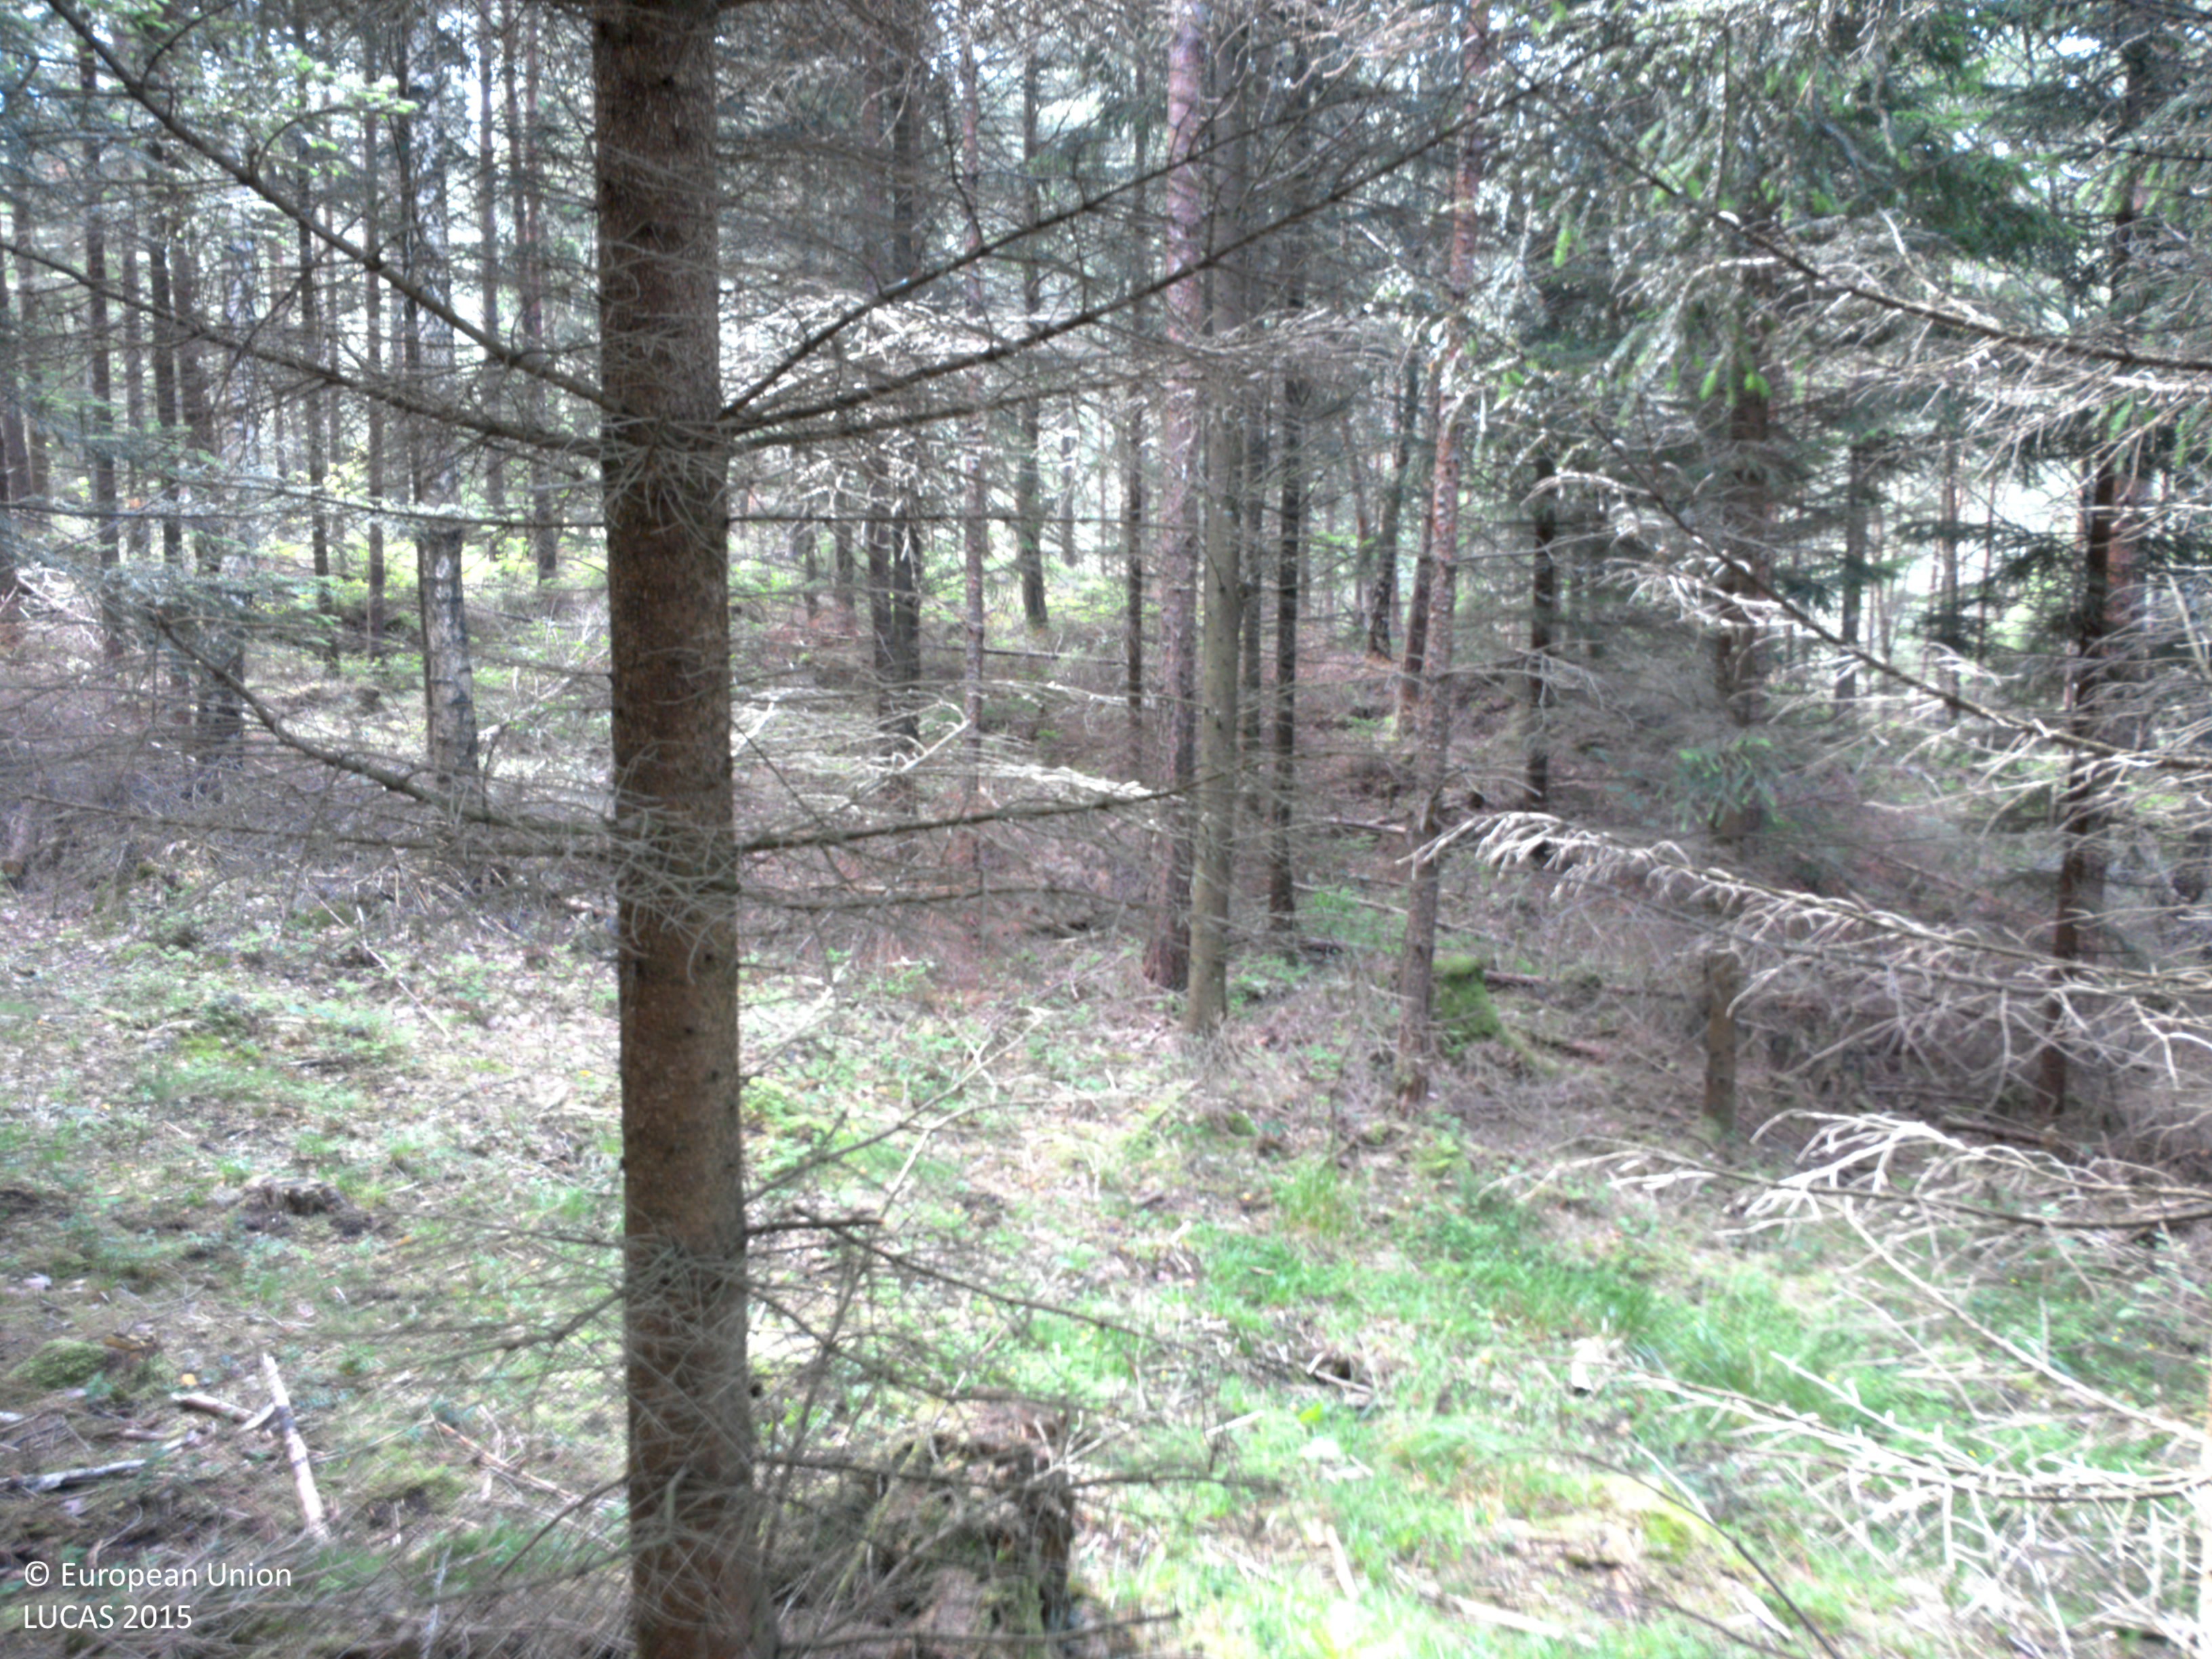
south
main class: Woodland
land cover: Other coniferous woodland
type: boreal forest
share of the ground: > 75 %
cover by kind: coniferous forest trees 90 %, shrubs 5 %, lichens and mosses 5 %
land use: Forestry
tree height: > 5 m
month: August
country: SE
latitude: 58.0076
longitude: 11.9426
